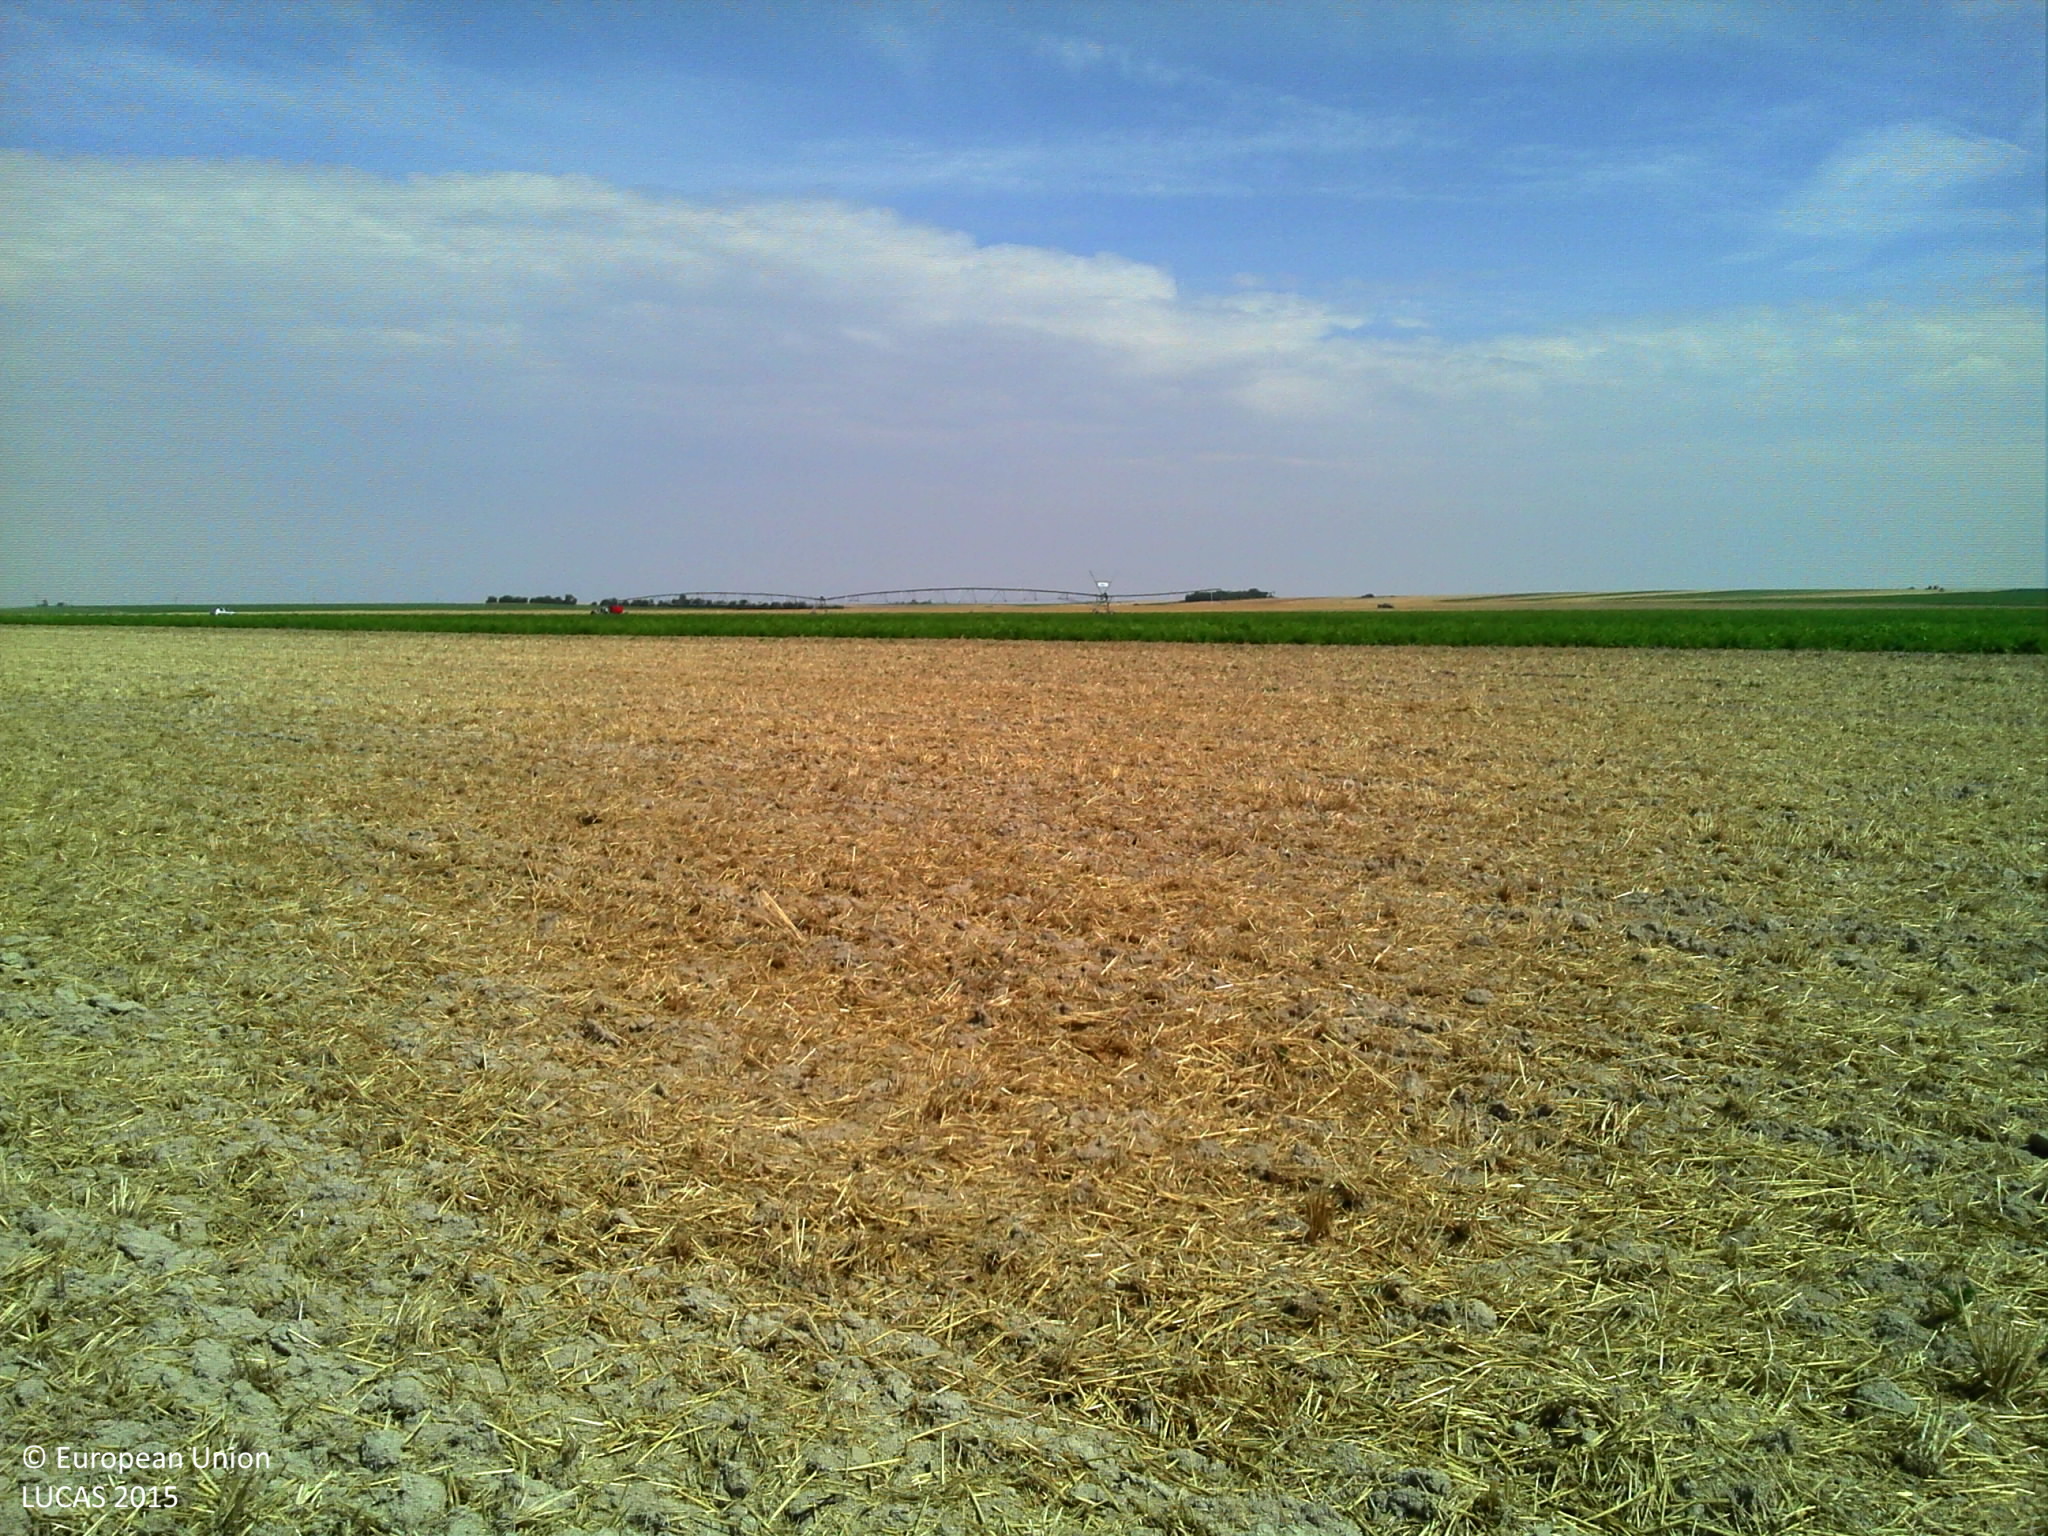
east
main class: Cropland
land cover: Common wheat
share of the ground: > 75 %
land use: Agriculture (excluding fallow land and kitchen gardens)
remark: Harvested field
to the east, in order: Common wheat; Potatoes
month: August
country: FR
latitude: 48.9529
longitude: 4.1646
